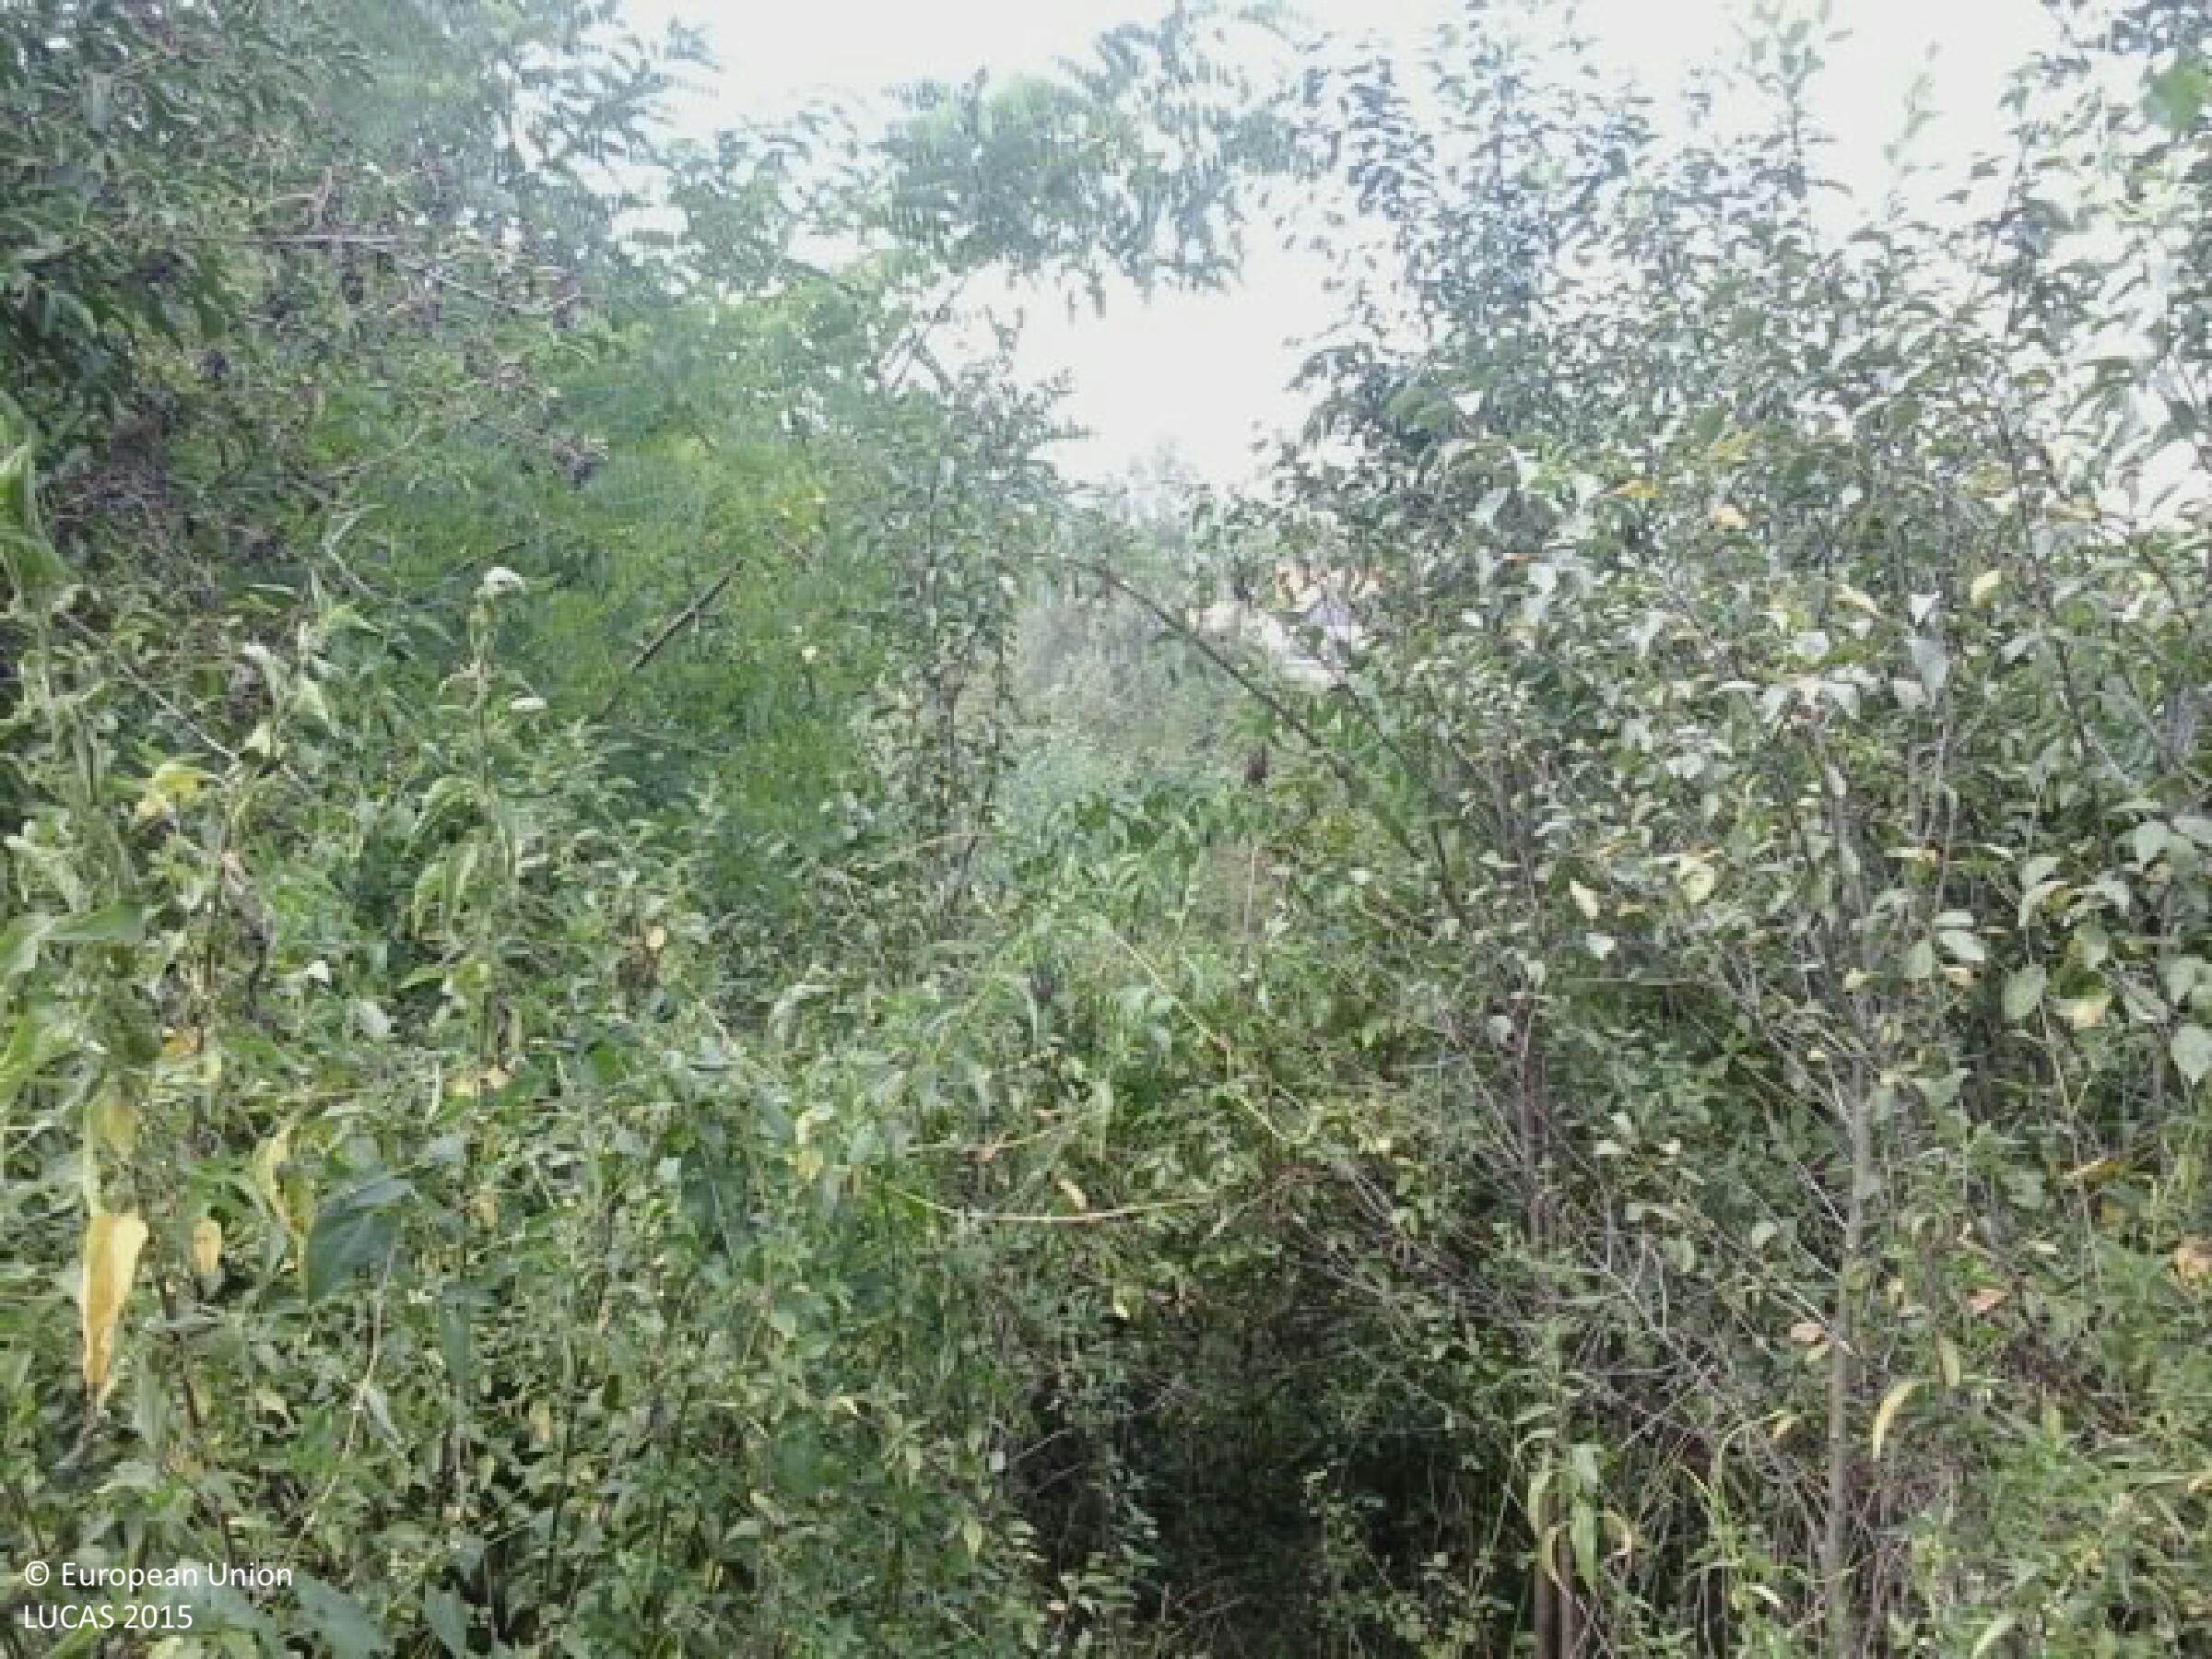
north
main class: Shrubland
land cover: Shrubland without tree cover
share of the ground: > 75 %
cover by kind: shrubs 60 %, herbaceous plants 40 %
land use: Fallow land
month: August
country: HU
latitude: 46.5260
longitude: 18.1824
